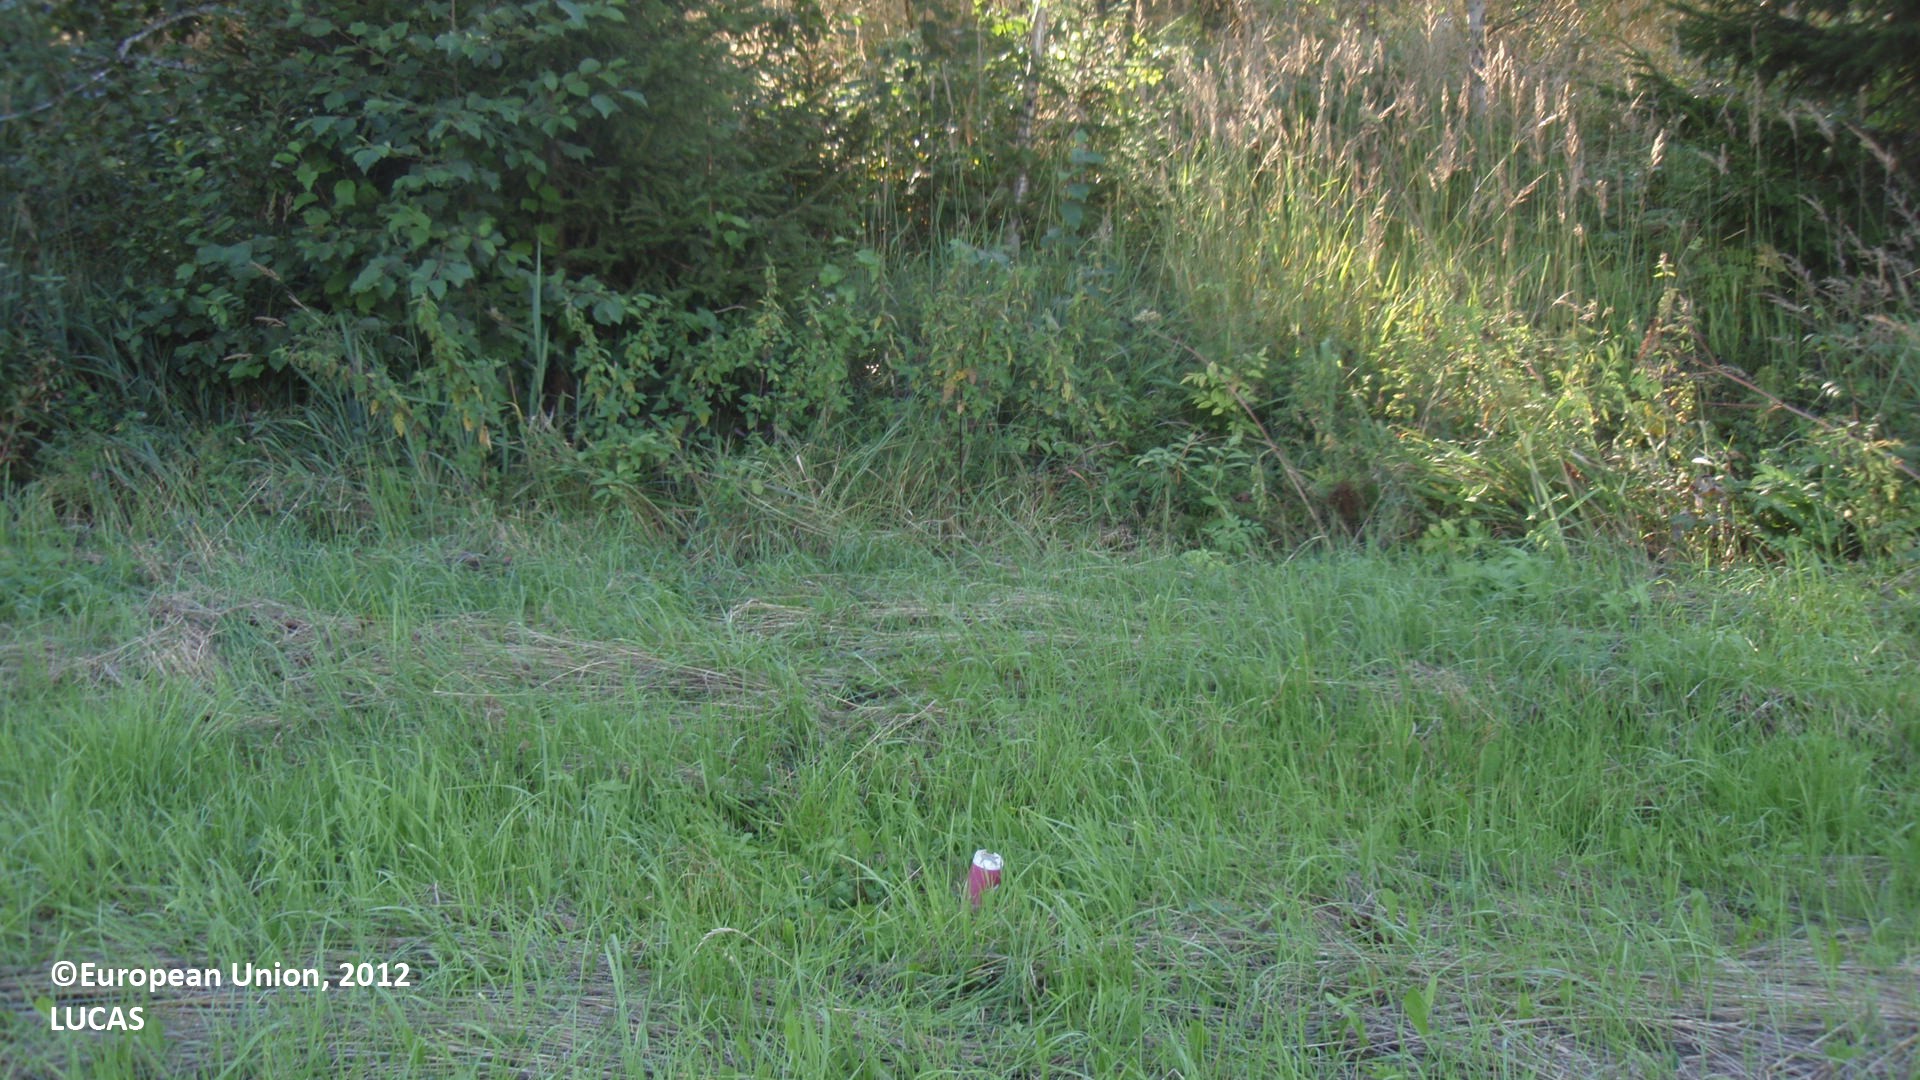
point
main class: Cropland
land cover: Mixed cereals for fodder
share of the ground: > 75 %
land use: Agriculture (excluding fallow land and kitchen gardens)
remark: Harvested field
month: August
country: FI
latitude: 60.7756
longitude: 26.5899
